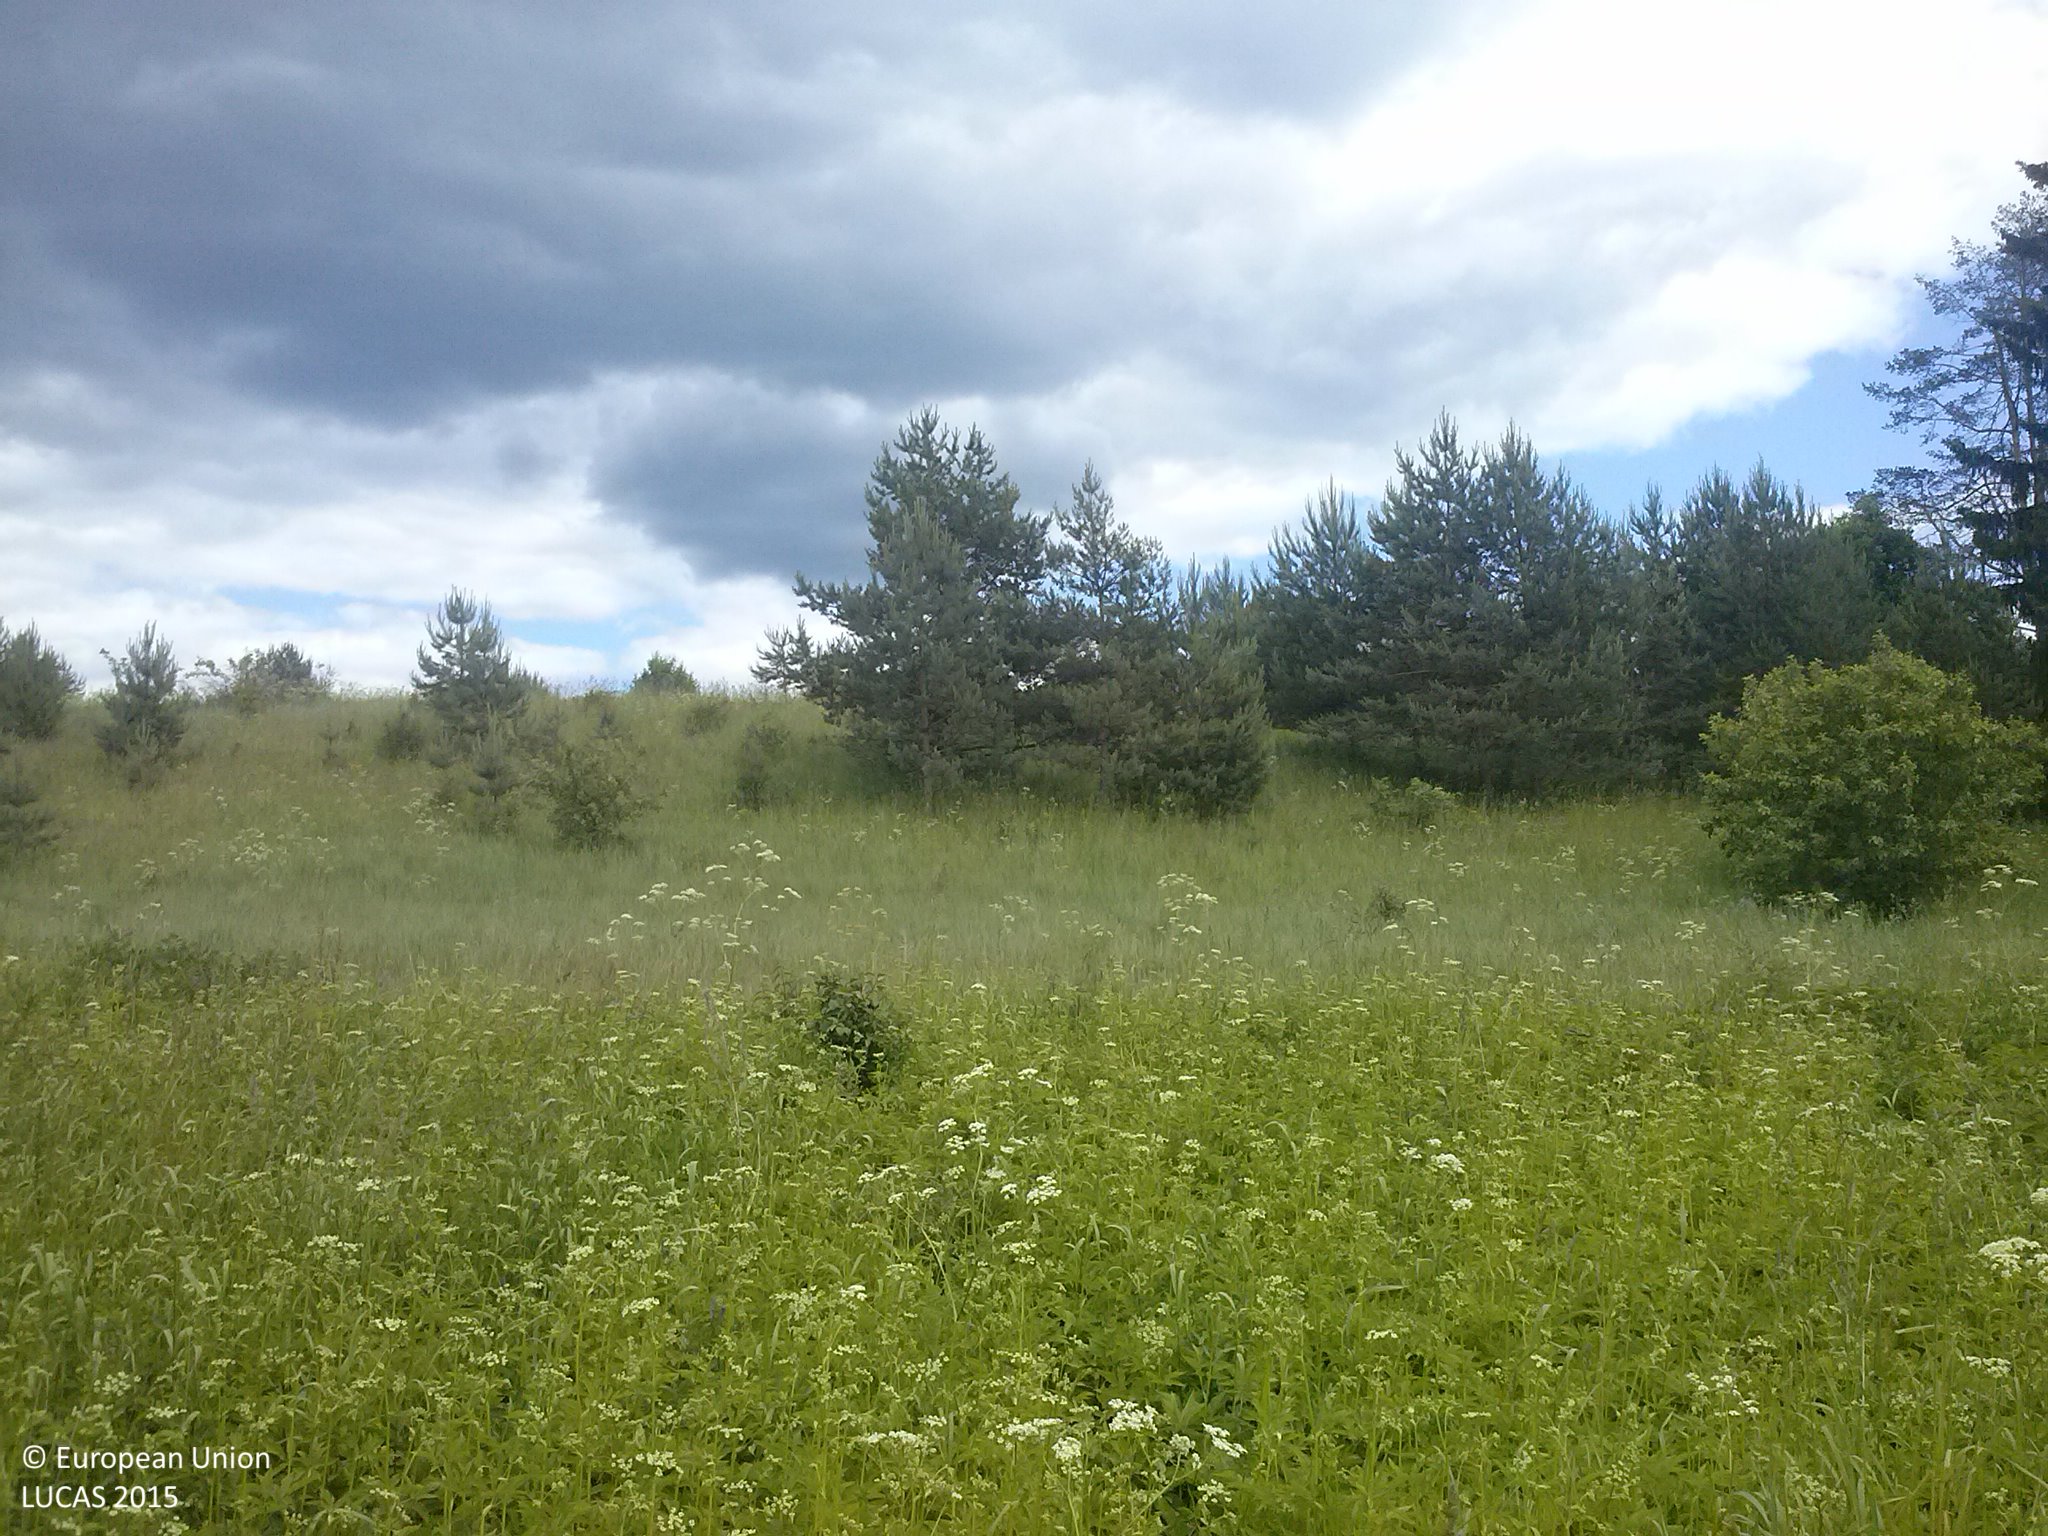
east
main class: Grassland
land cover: Spontaneously vegetated surfaces
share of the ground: > 75 %
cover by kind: herbaceous plants 100 %
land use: Semi-natural and natural areas not in use
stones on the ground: < 10 %
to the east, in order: Spontaneously vegetated surfaces; Paved roads, cycling and walking lanes; Spontaneously vegetated surfaces; Grassland with sparse tree/shrub cover; Pine dominated coniferous woodland; Grassland without tree/shrub cover
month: June
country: LV
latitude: 56.4224
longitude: 27.6786
